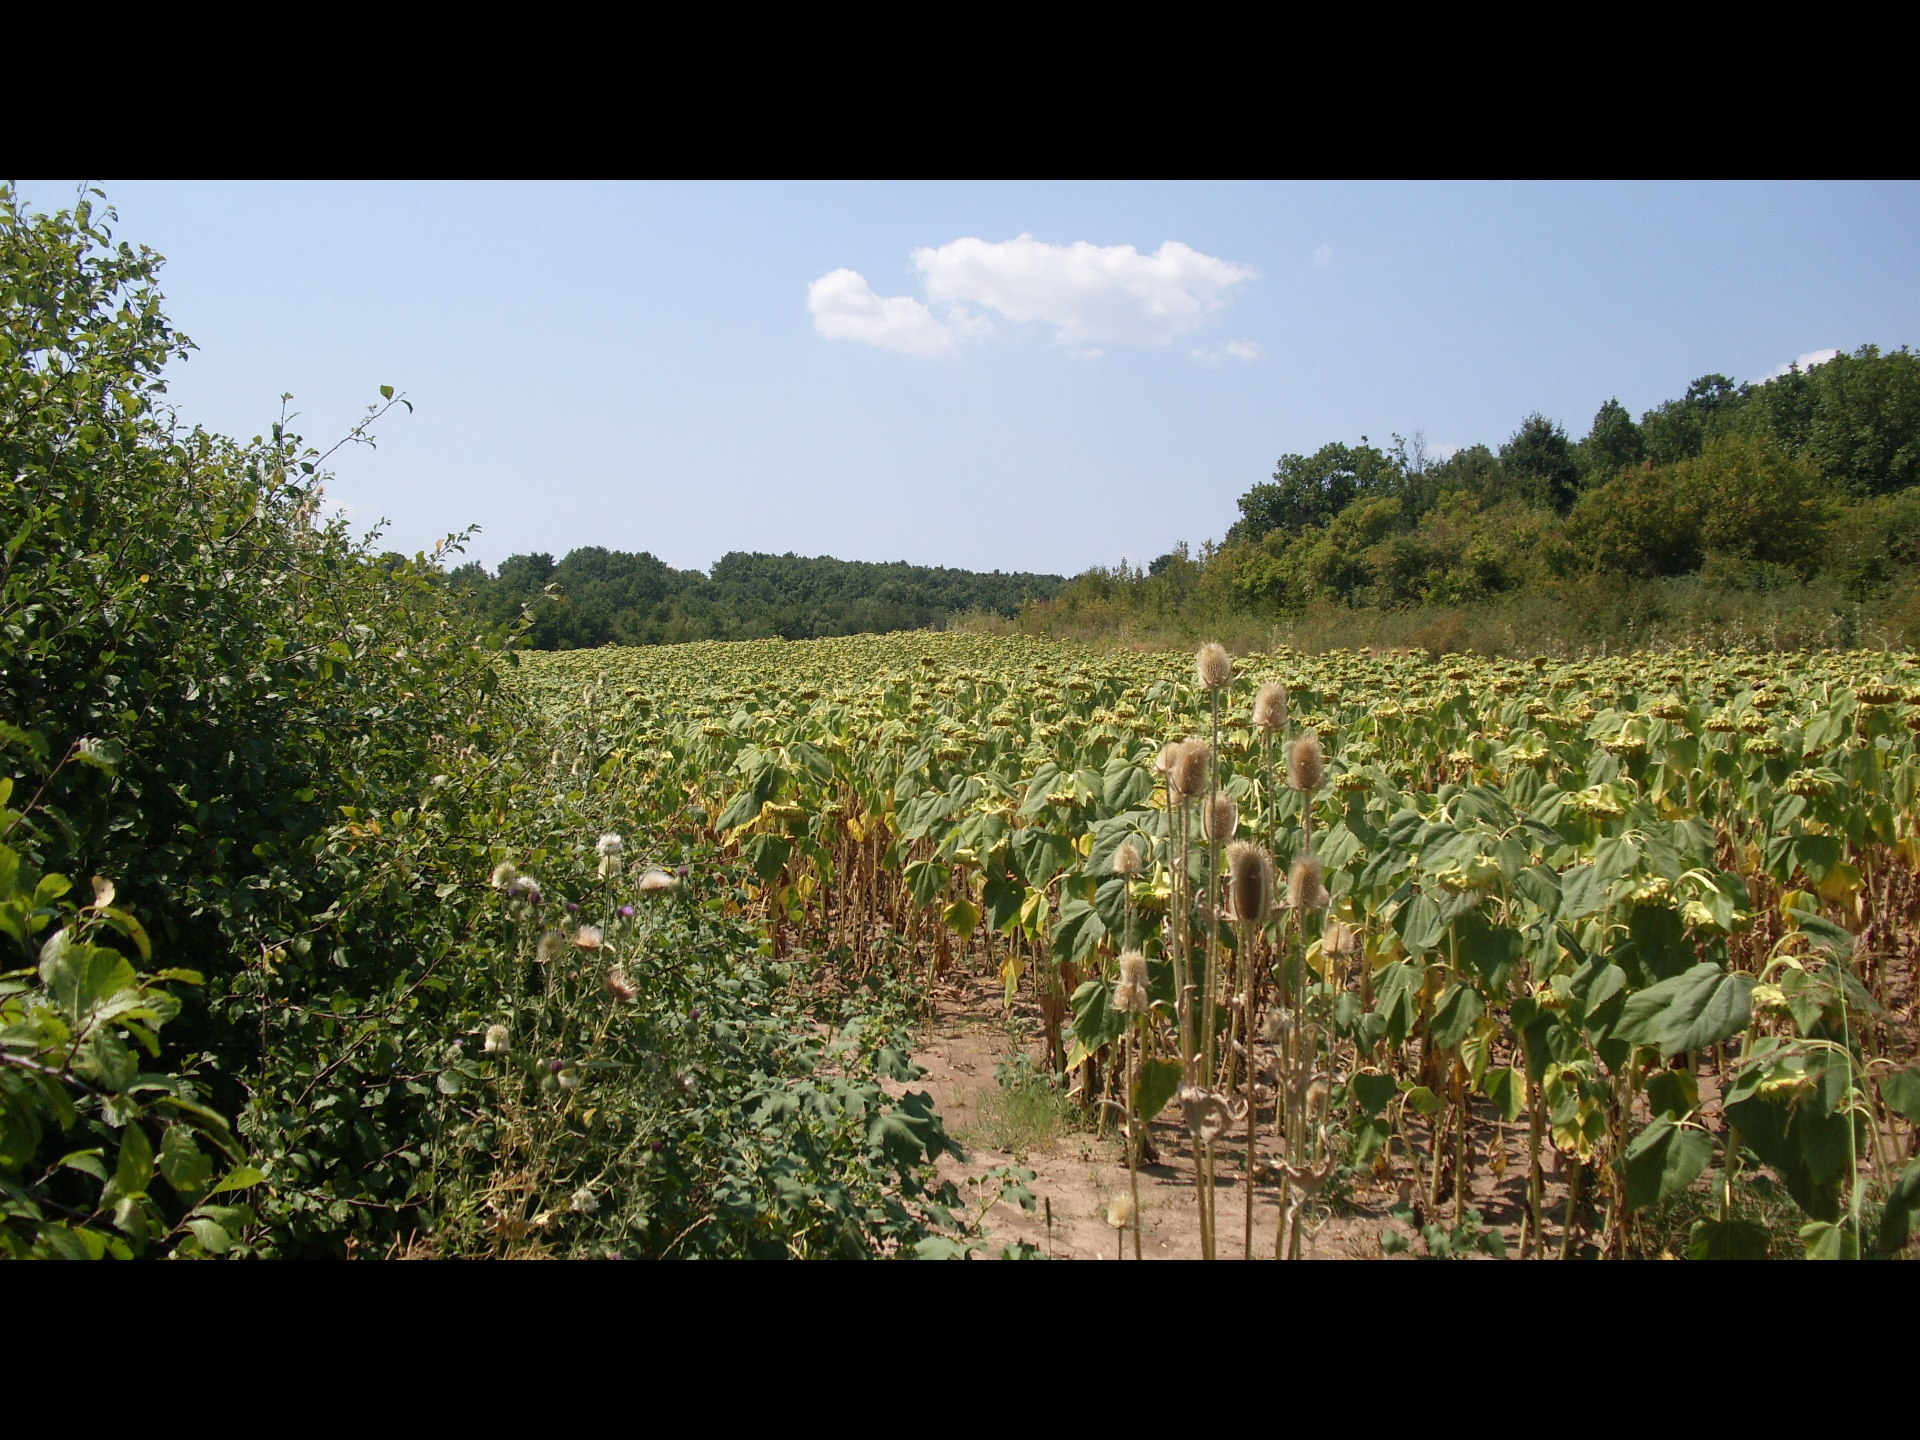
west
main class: Shrubland
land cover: Shrubland without tree cover
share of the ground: > 75 %
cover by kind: shrubs 95 %, herbaceous plants 5 %
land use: Agriculture (excluding fallow land and kitchen gardens)
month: August
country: BG
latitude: 43.2988
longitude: 23.3658
